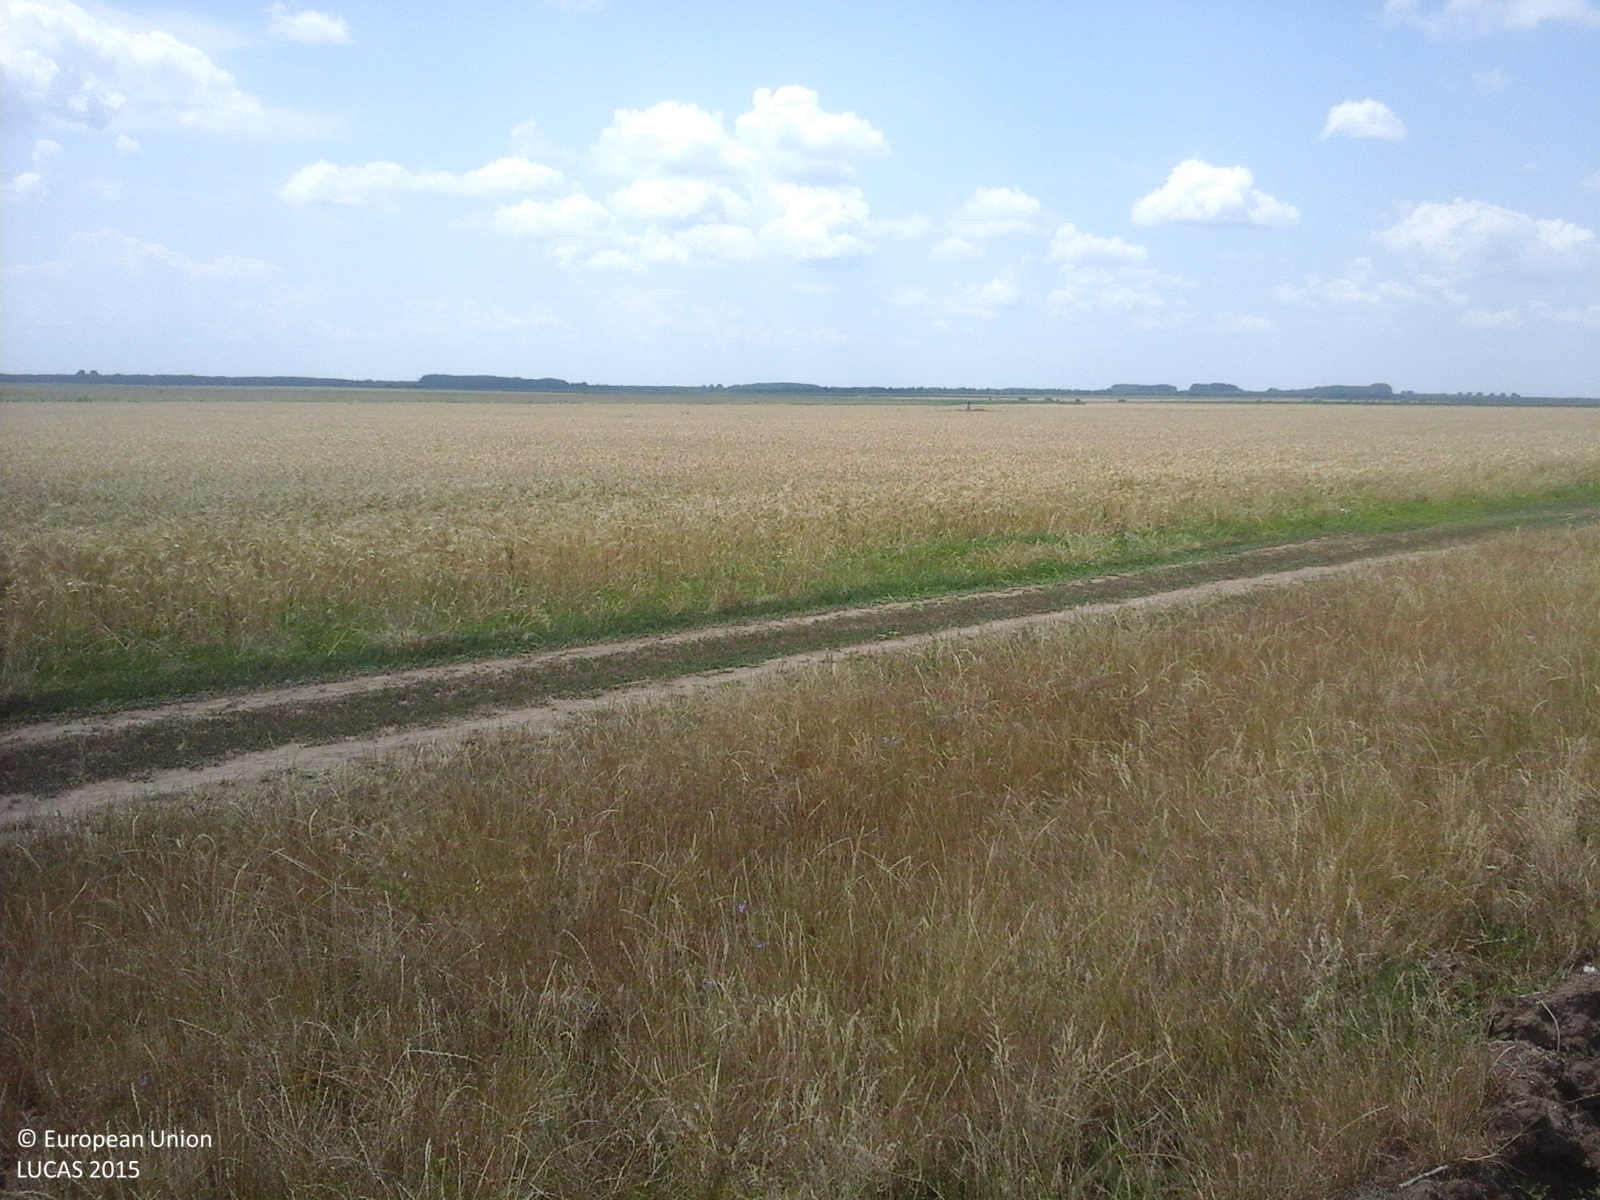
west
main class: Grassland
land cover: Spontaneously vegetated surfaces
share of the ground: > 75 %
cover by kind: herbaceous plants 100 %
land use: Fallow land
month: July
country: RO
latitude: 43.8789
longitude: 24.2107
